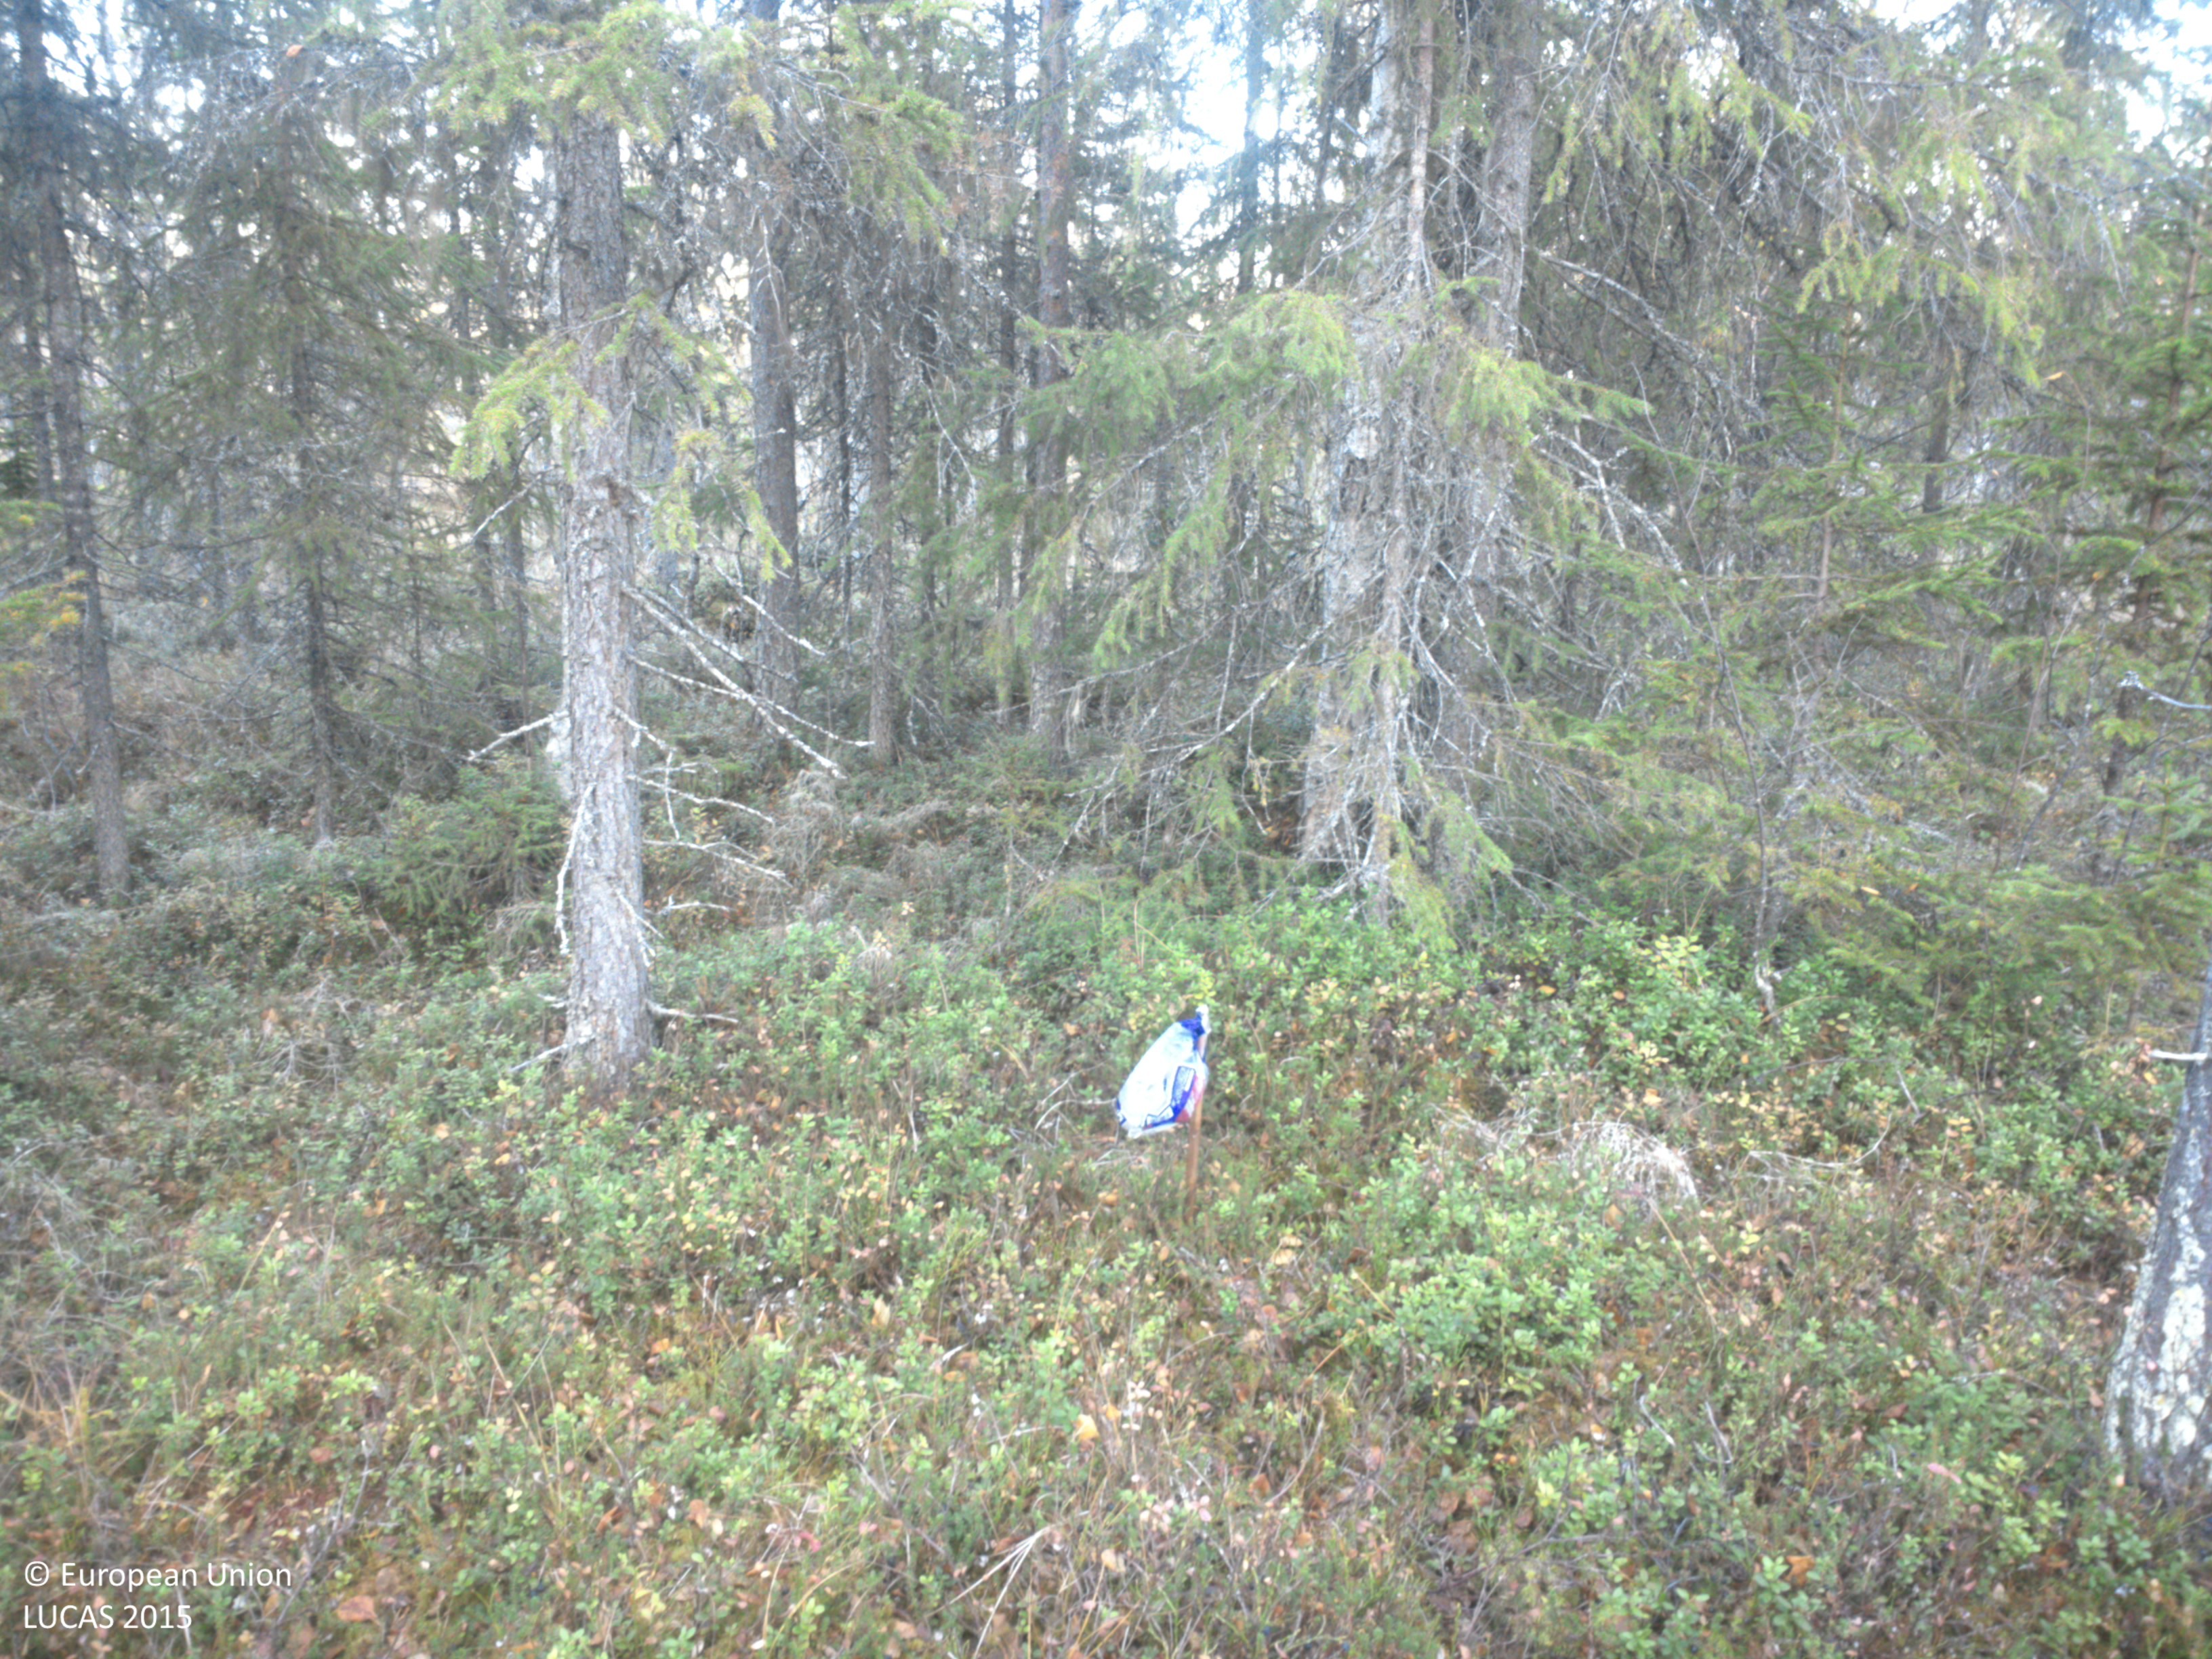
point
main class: Woodland
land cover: Spruce dominated mixed woodland
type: boreal forest
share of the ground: 50 - 75 %
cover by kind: coniferous forest trees 45 %, shrubs 40 %, broadleaved forest trees 15 %
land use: Forestry
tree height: > 5 m
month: October
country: SE
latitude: 64.8399
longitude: 18.2077
